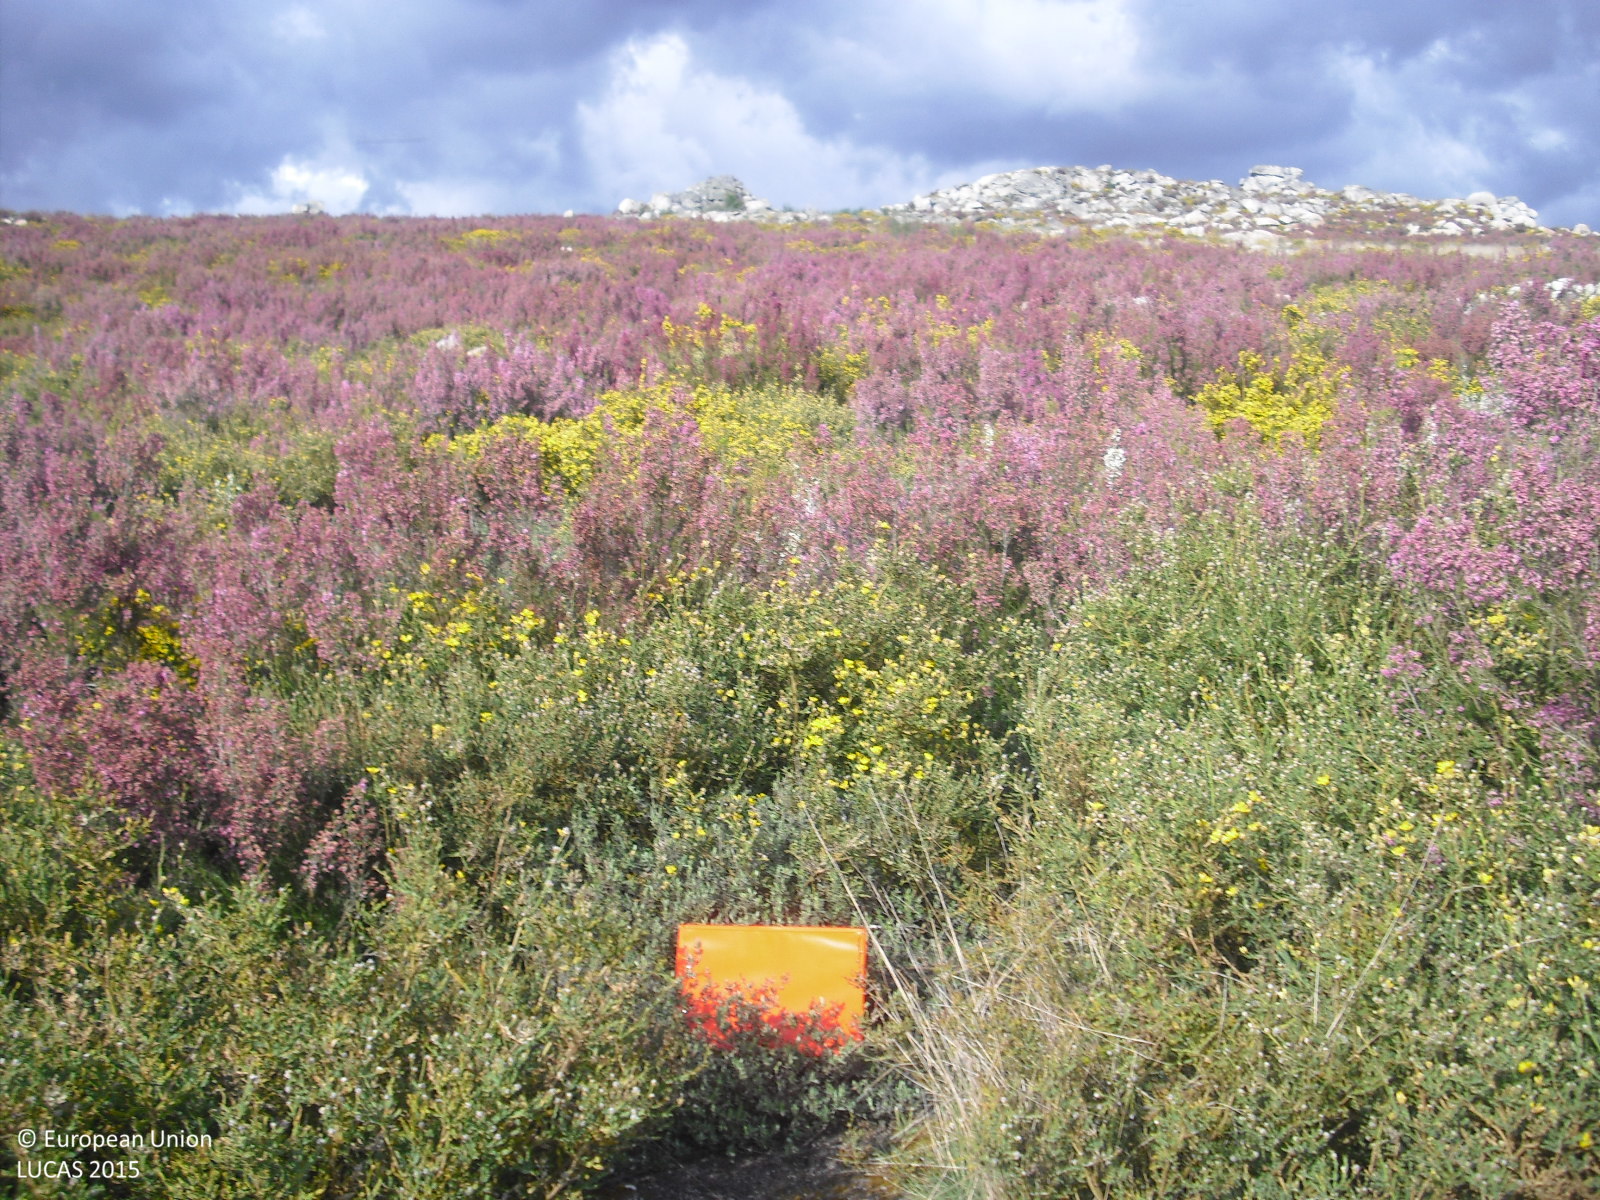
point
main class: Shrubland
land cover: Shrubland without tree cover
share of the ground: > 75 %
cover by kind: shrubs 70 %, consolidated bare surface 20 %, herbaceous plants 10 %
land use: Semi-natural and natural areas not in use
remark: Burnt area
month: April
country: ES
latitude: 41.9363
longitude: -7.7618
